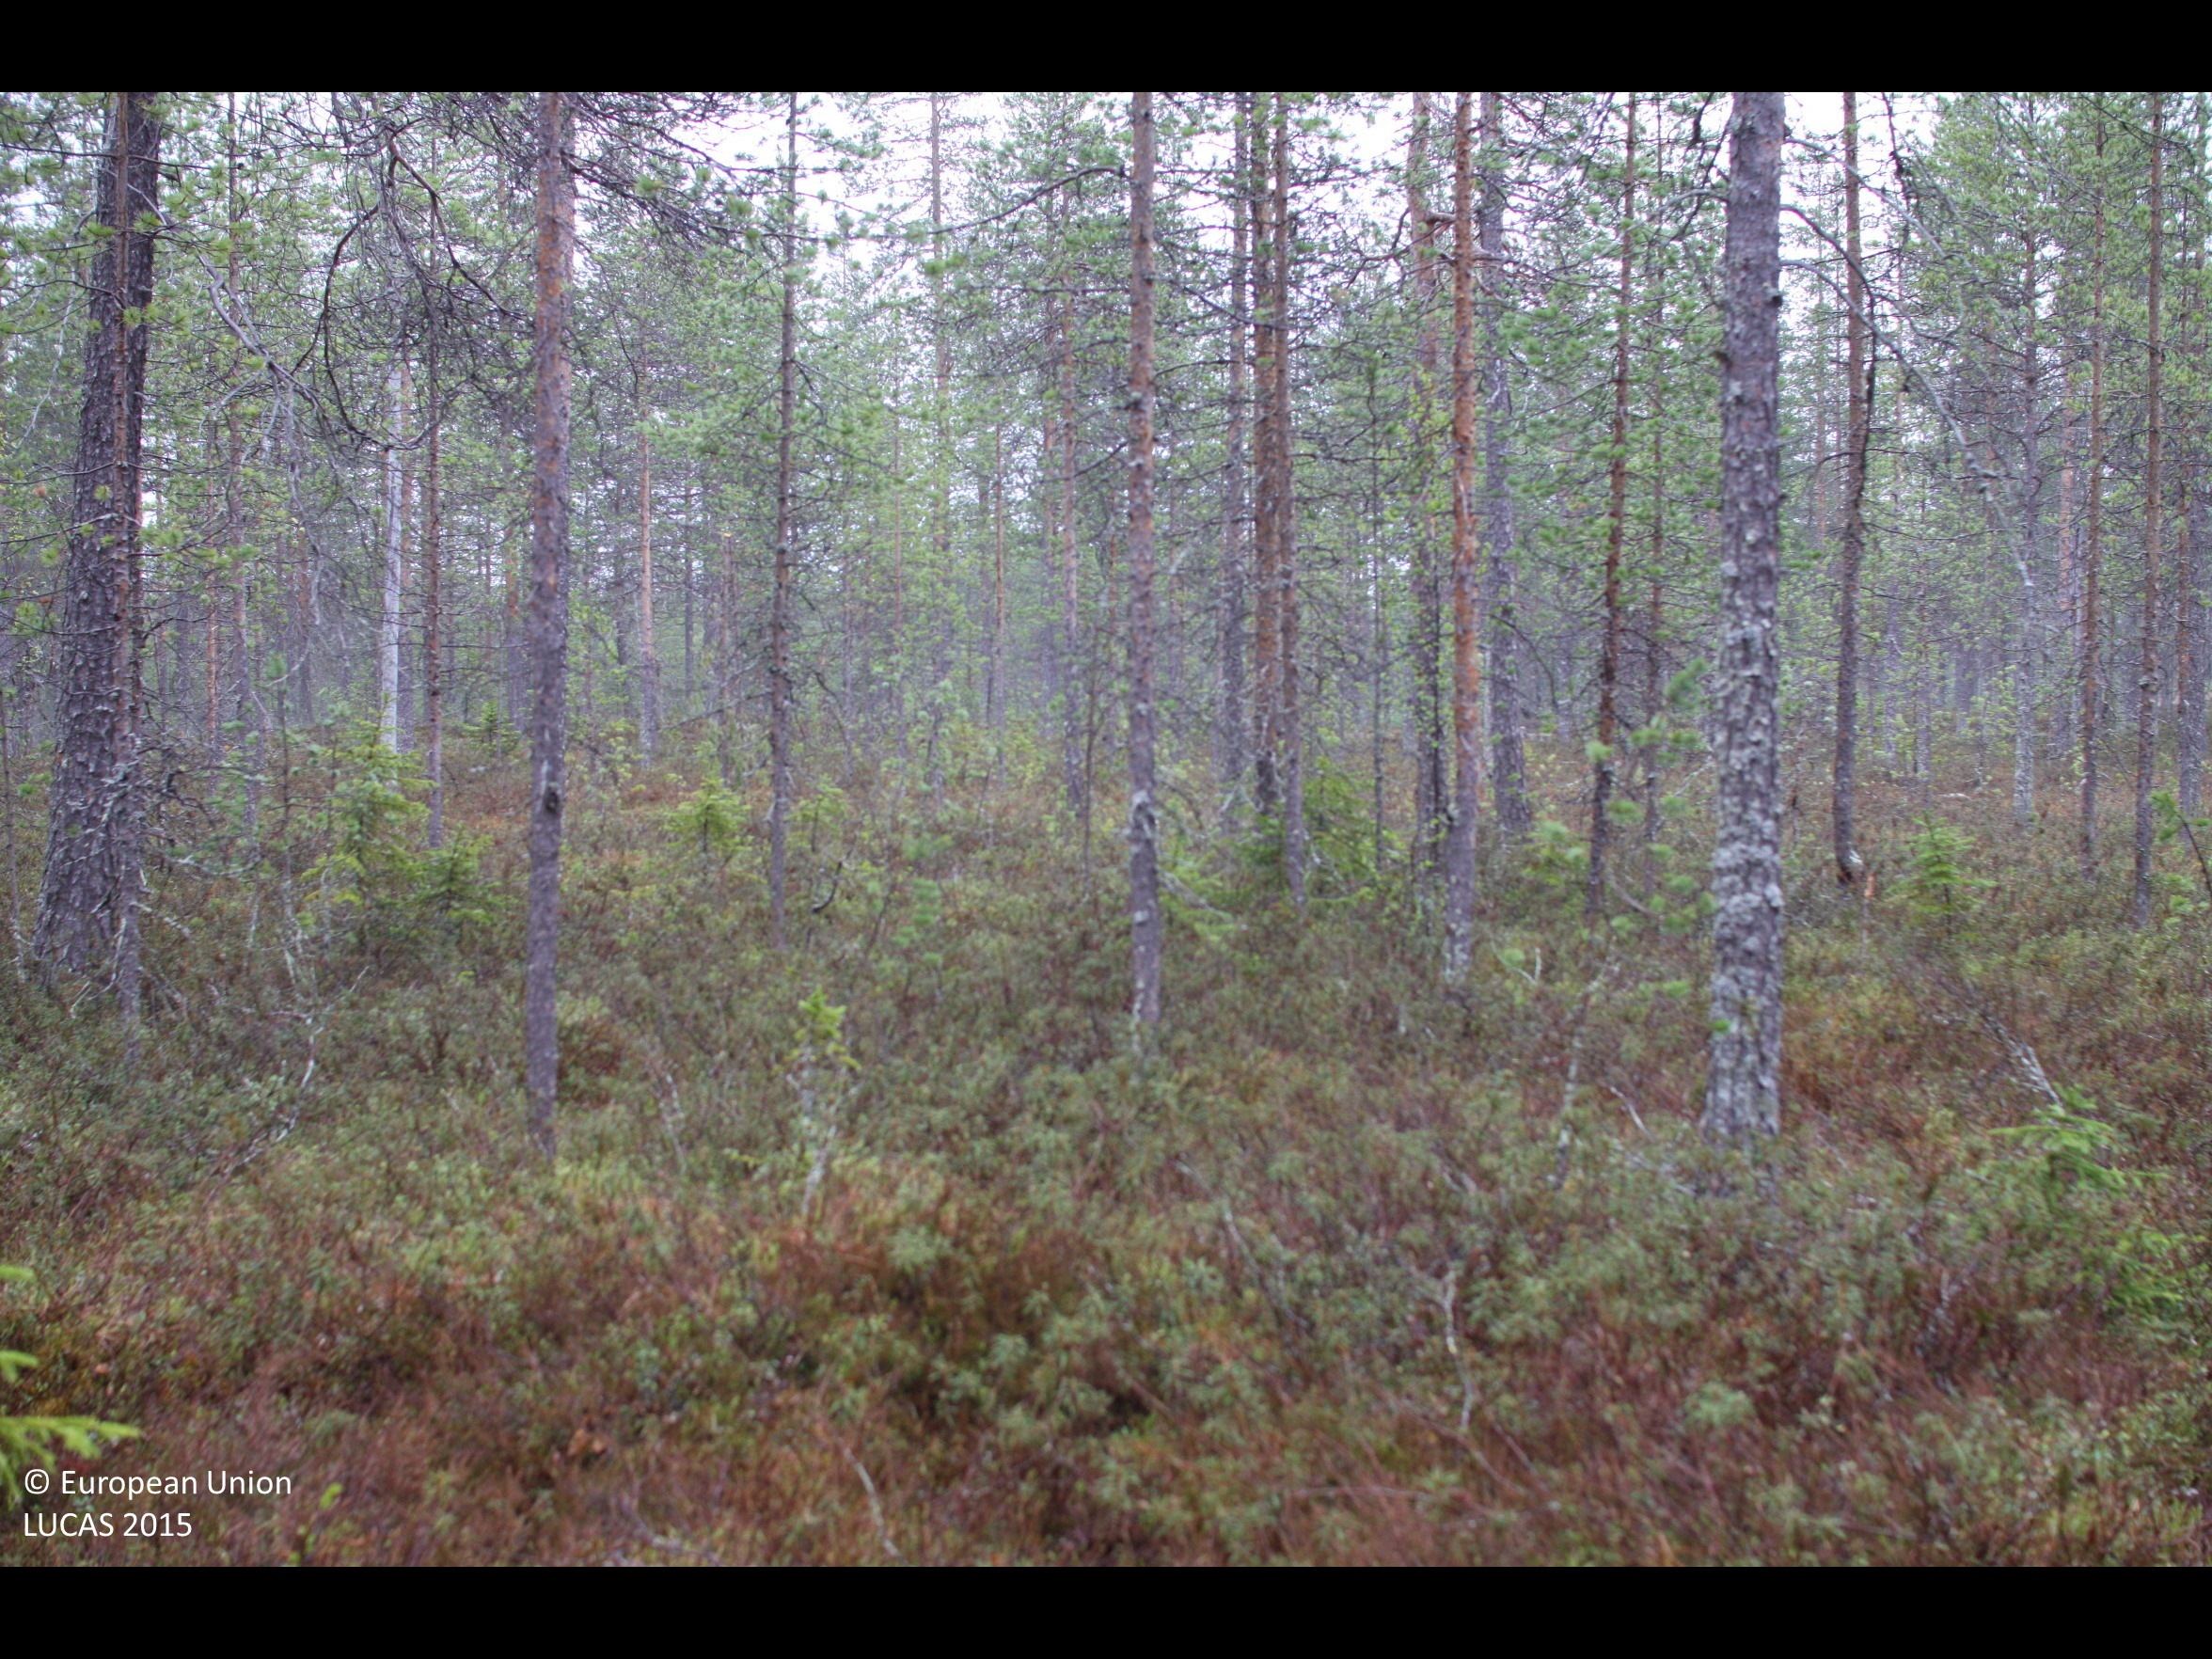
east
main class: Woodland
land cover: Pine dominated coniferous woodland
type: boreal forest
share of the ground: 50 - 75 %
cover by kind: coniferous forest trees 70 %, shrubs 30 %
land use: Forestry
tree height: > 5 m
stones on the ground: < 10 %
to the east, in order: Pine dominated coniferous woodland; Shrubland with sparse tree cover; Ditches and canals; Shruby margins; Tracks; Shruby margins; Ditches and canals; Pine dominated coniferous woodland
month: June
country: FI
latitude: 66.3383
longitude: 27.3277
